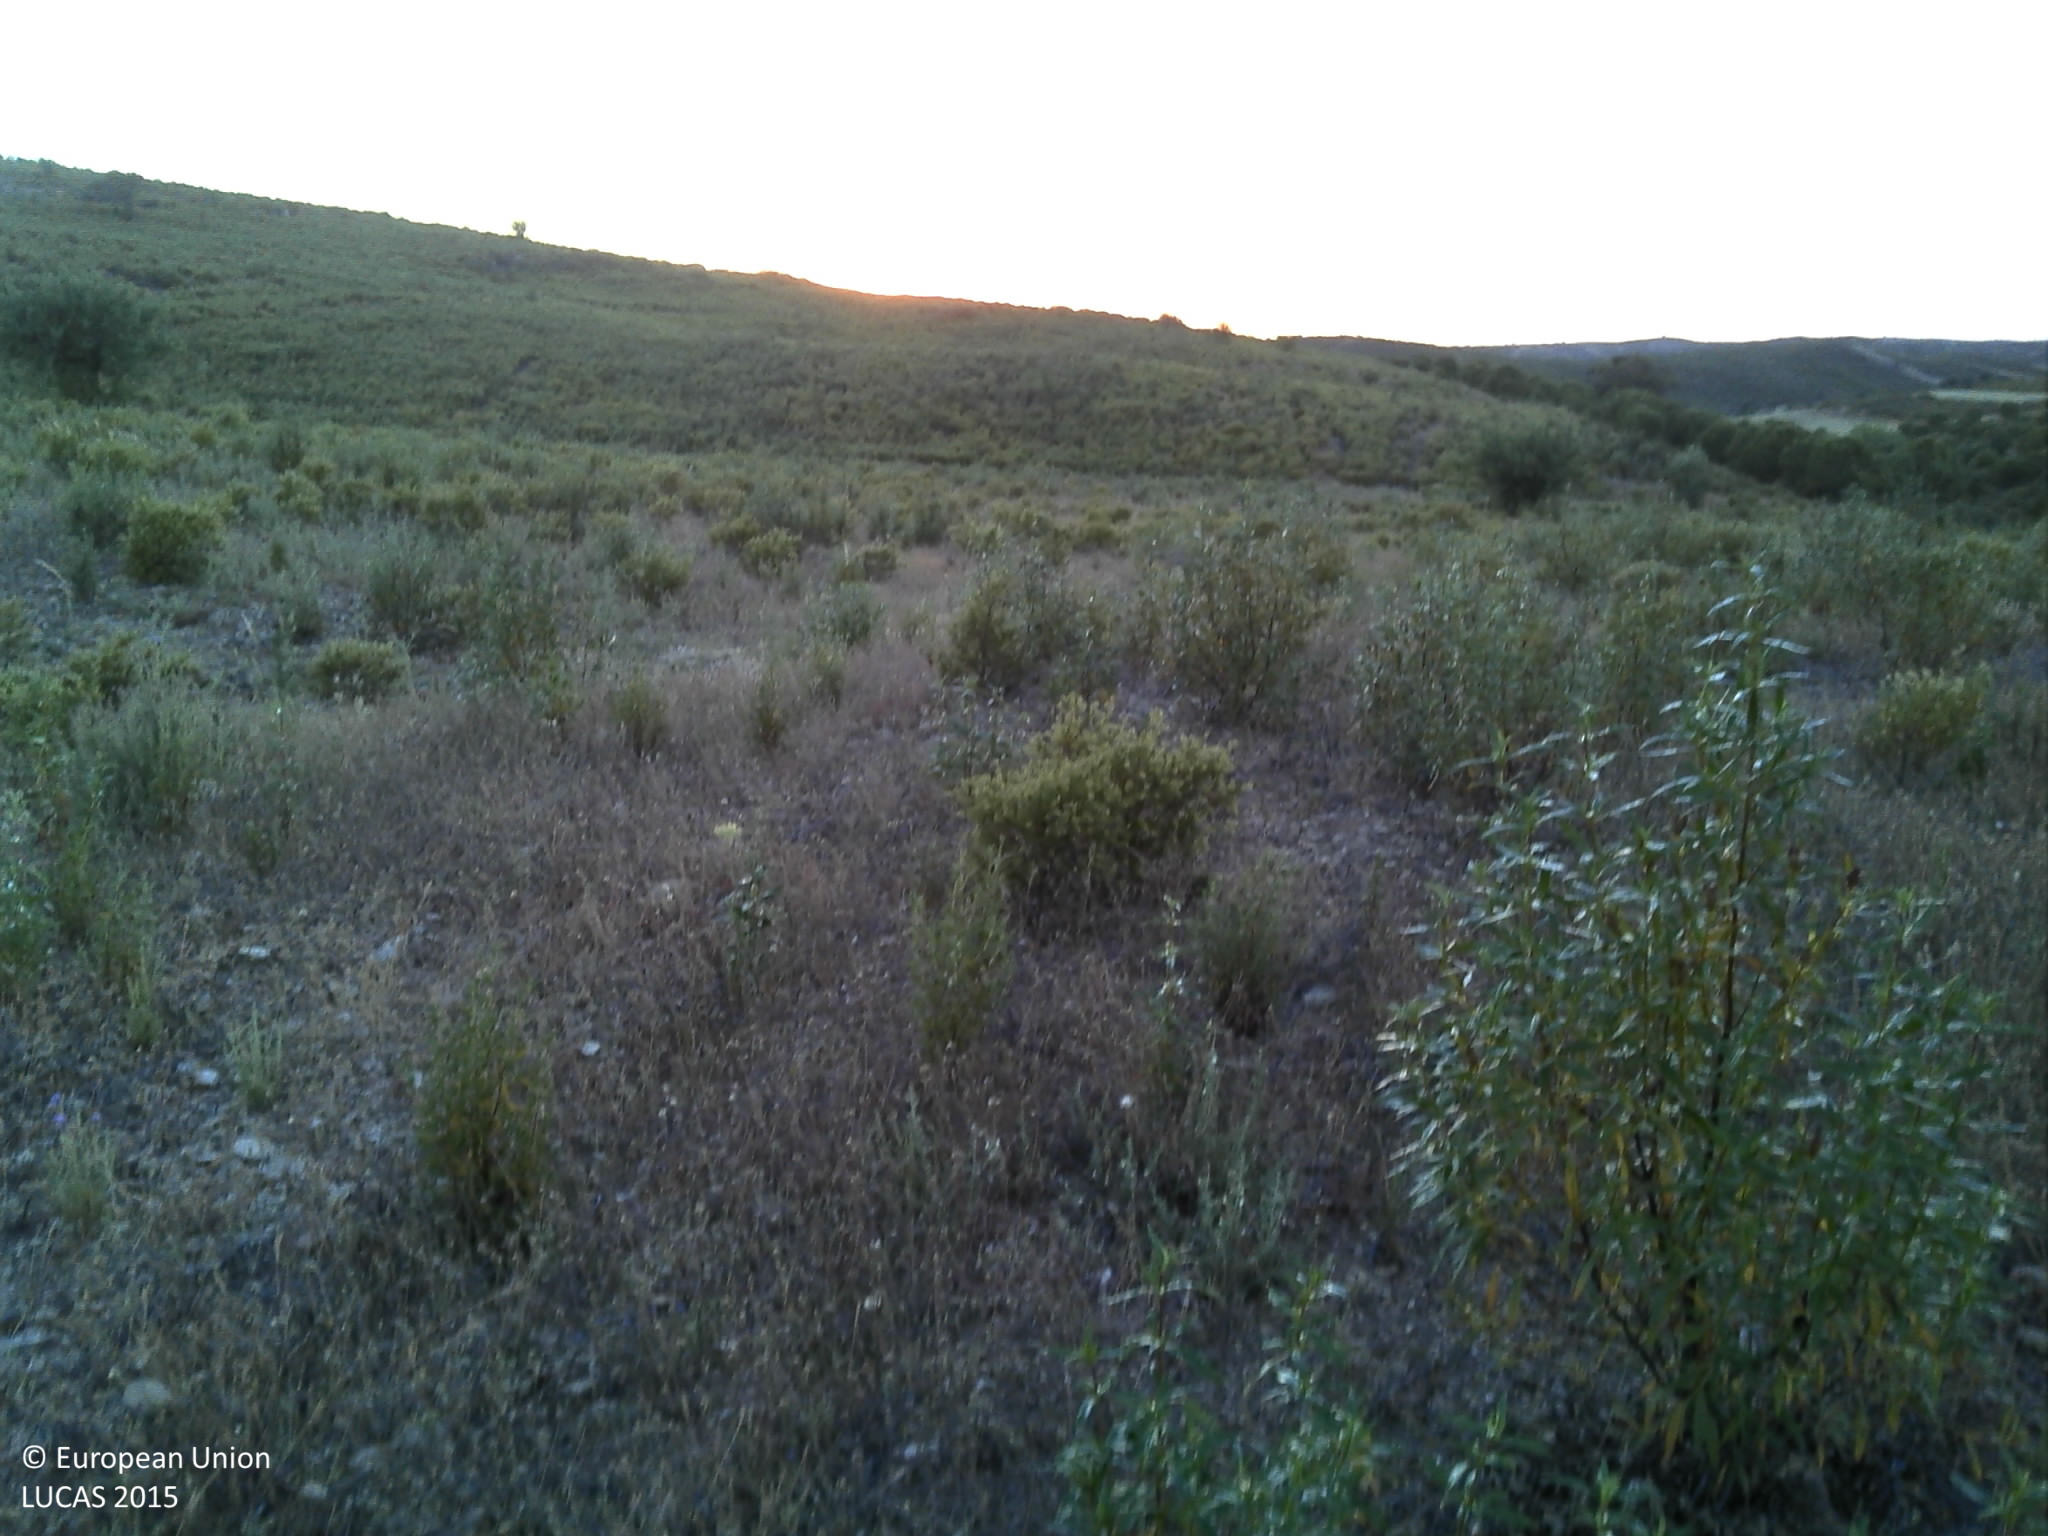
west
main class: Shrubland
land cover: Shrubland without tree cover
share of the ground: 10 - 25 %
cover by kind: herbaceous plants 65 %, shrubs 25 %, unconsolidated bare surface 10 %
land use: Abandoned areas
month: May
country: PT
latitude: 37.4356
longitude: -7.5379
